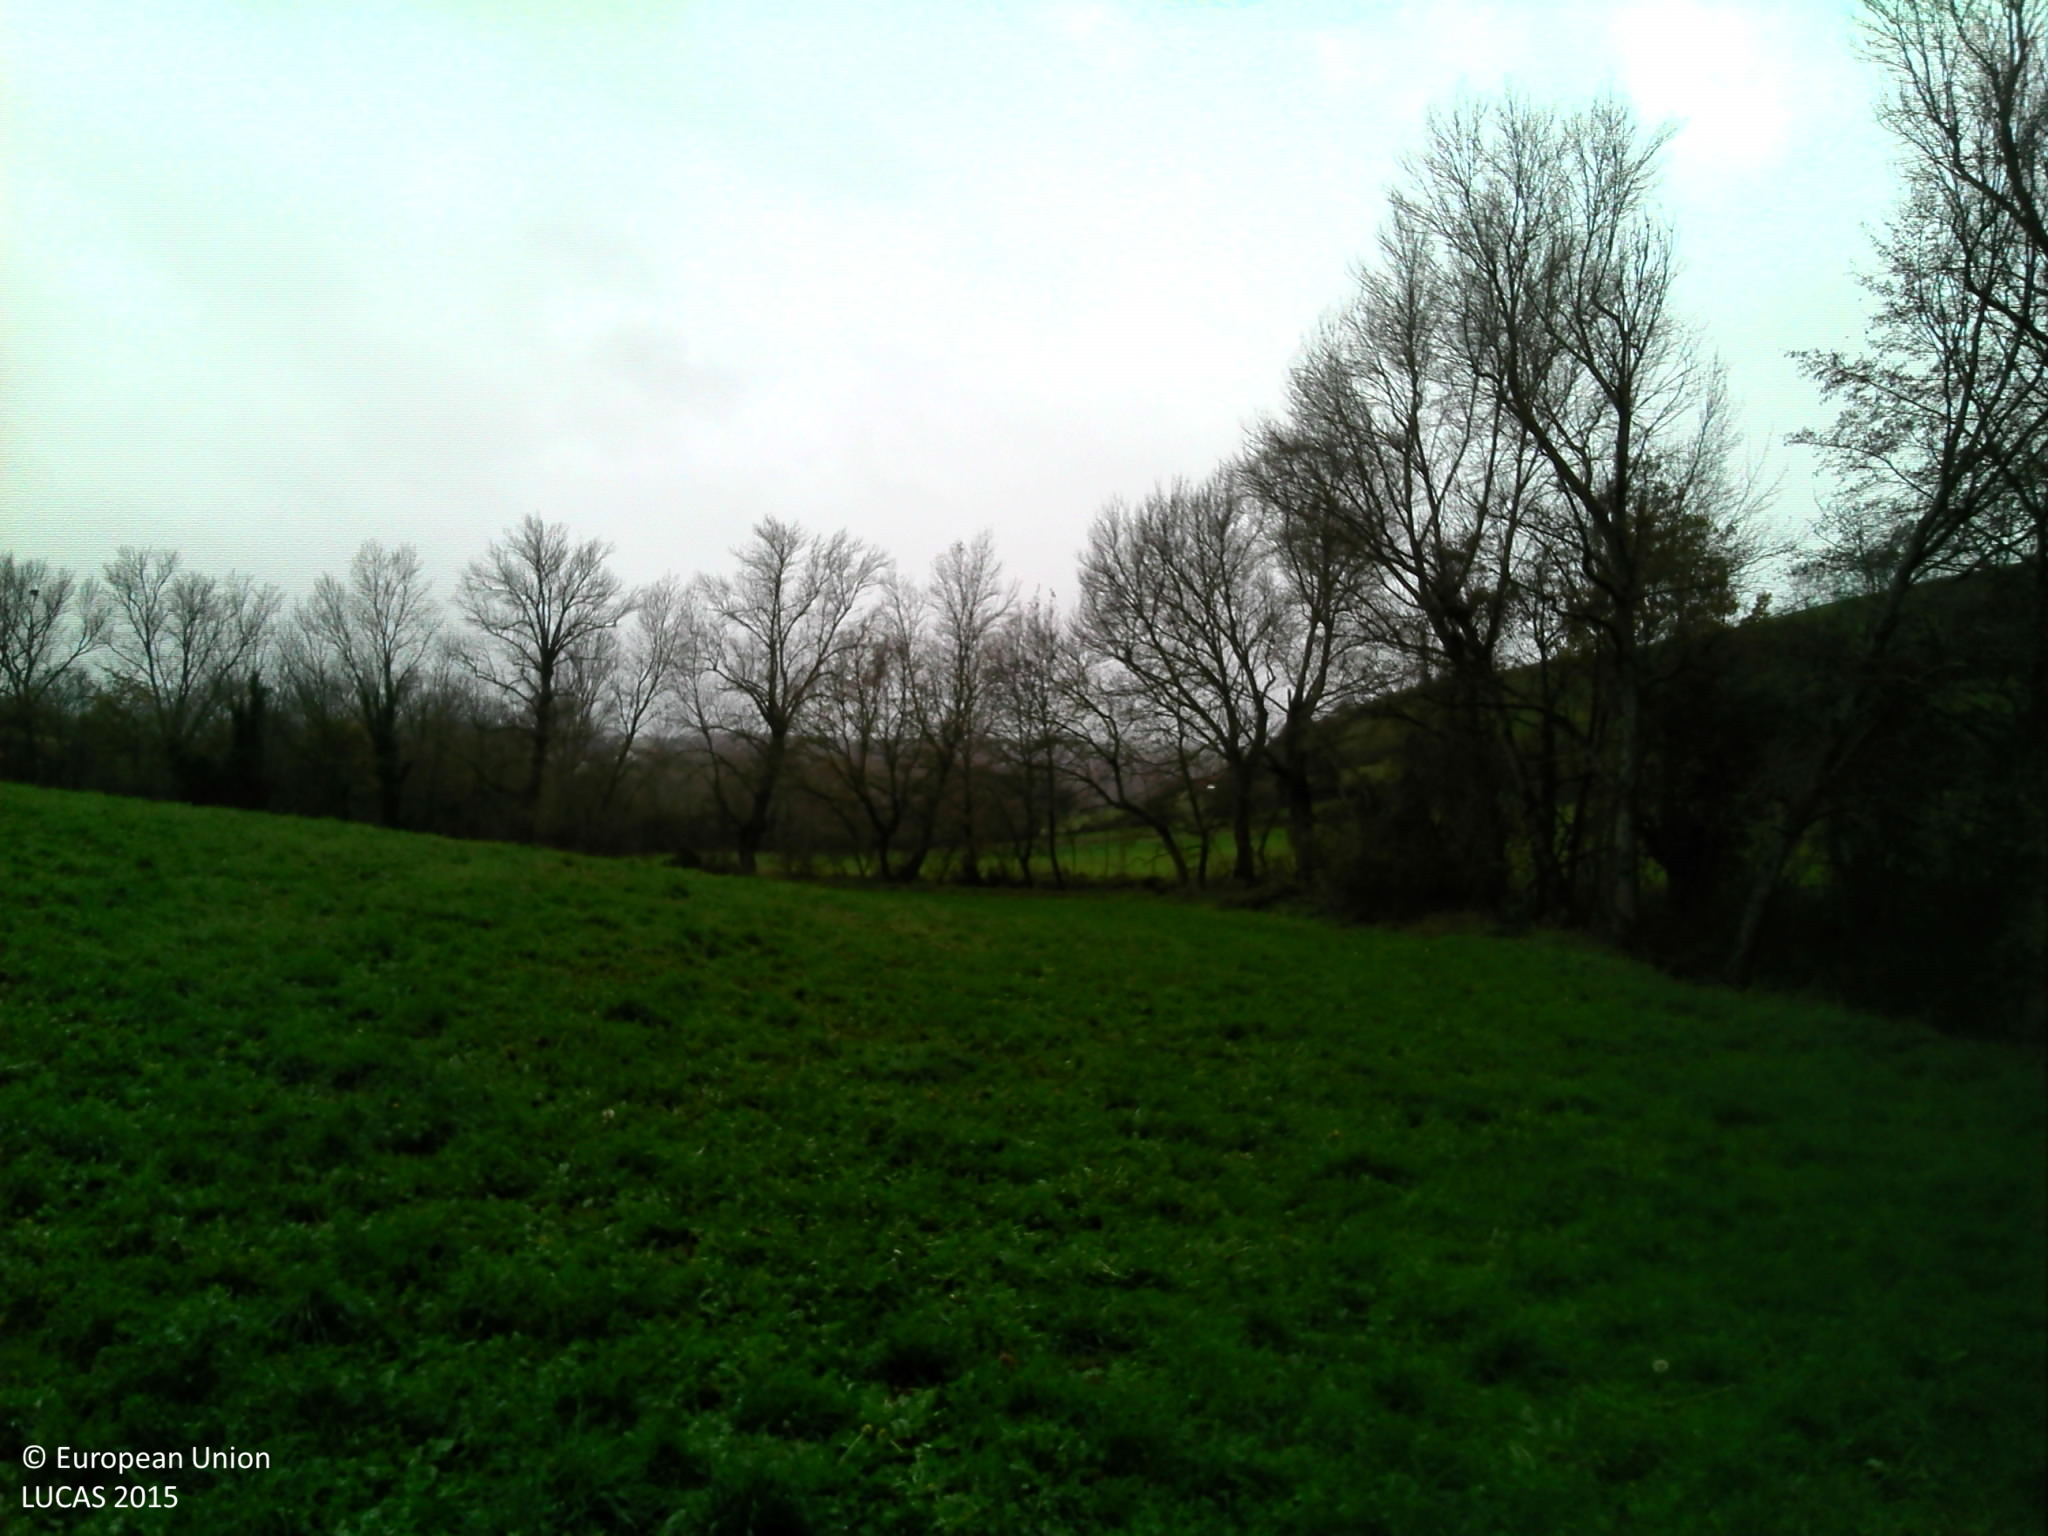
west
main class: Cropland
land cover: Temporary grasslands
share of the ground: > 75 %
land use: Agriculture (excluding fallow land and kitchen gardens)
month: November
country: FR
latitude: 44.0420
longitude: 3.0048
